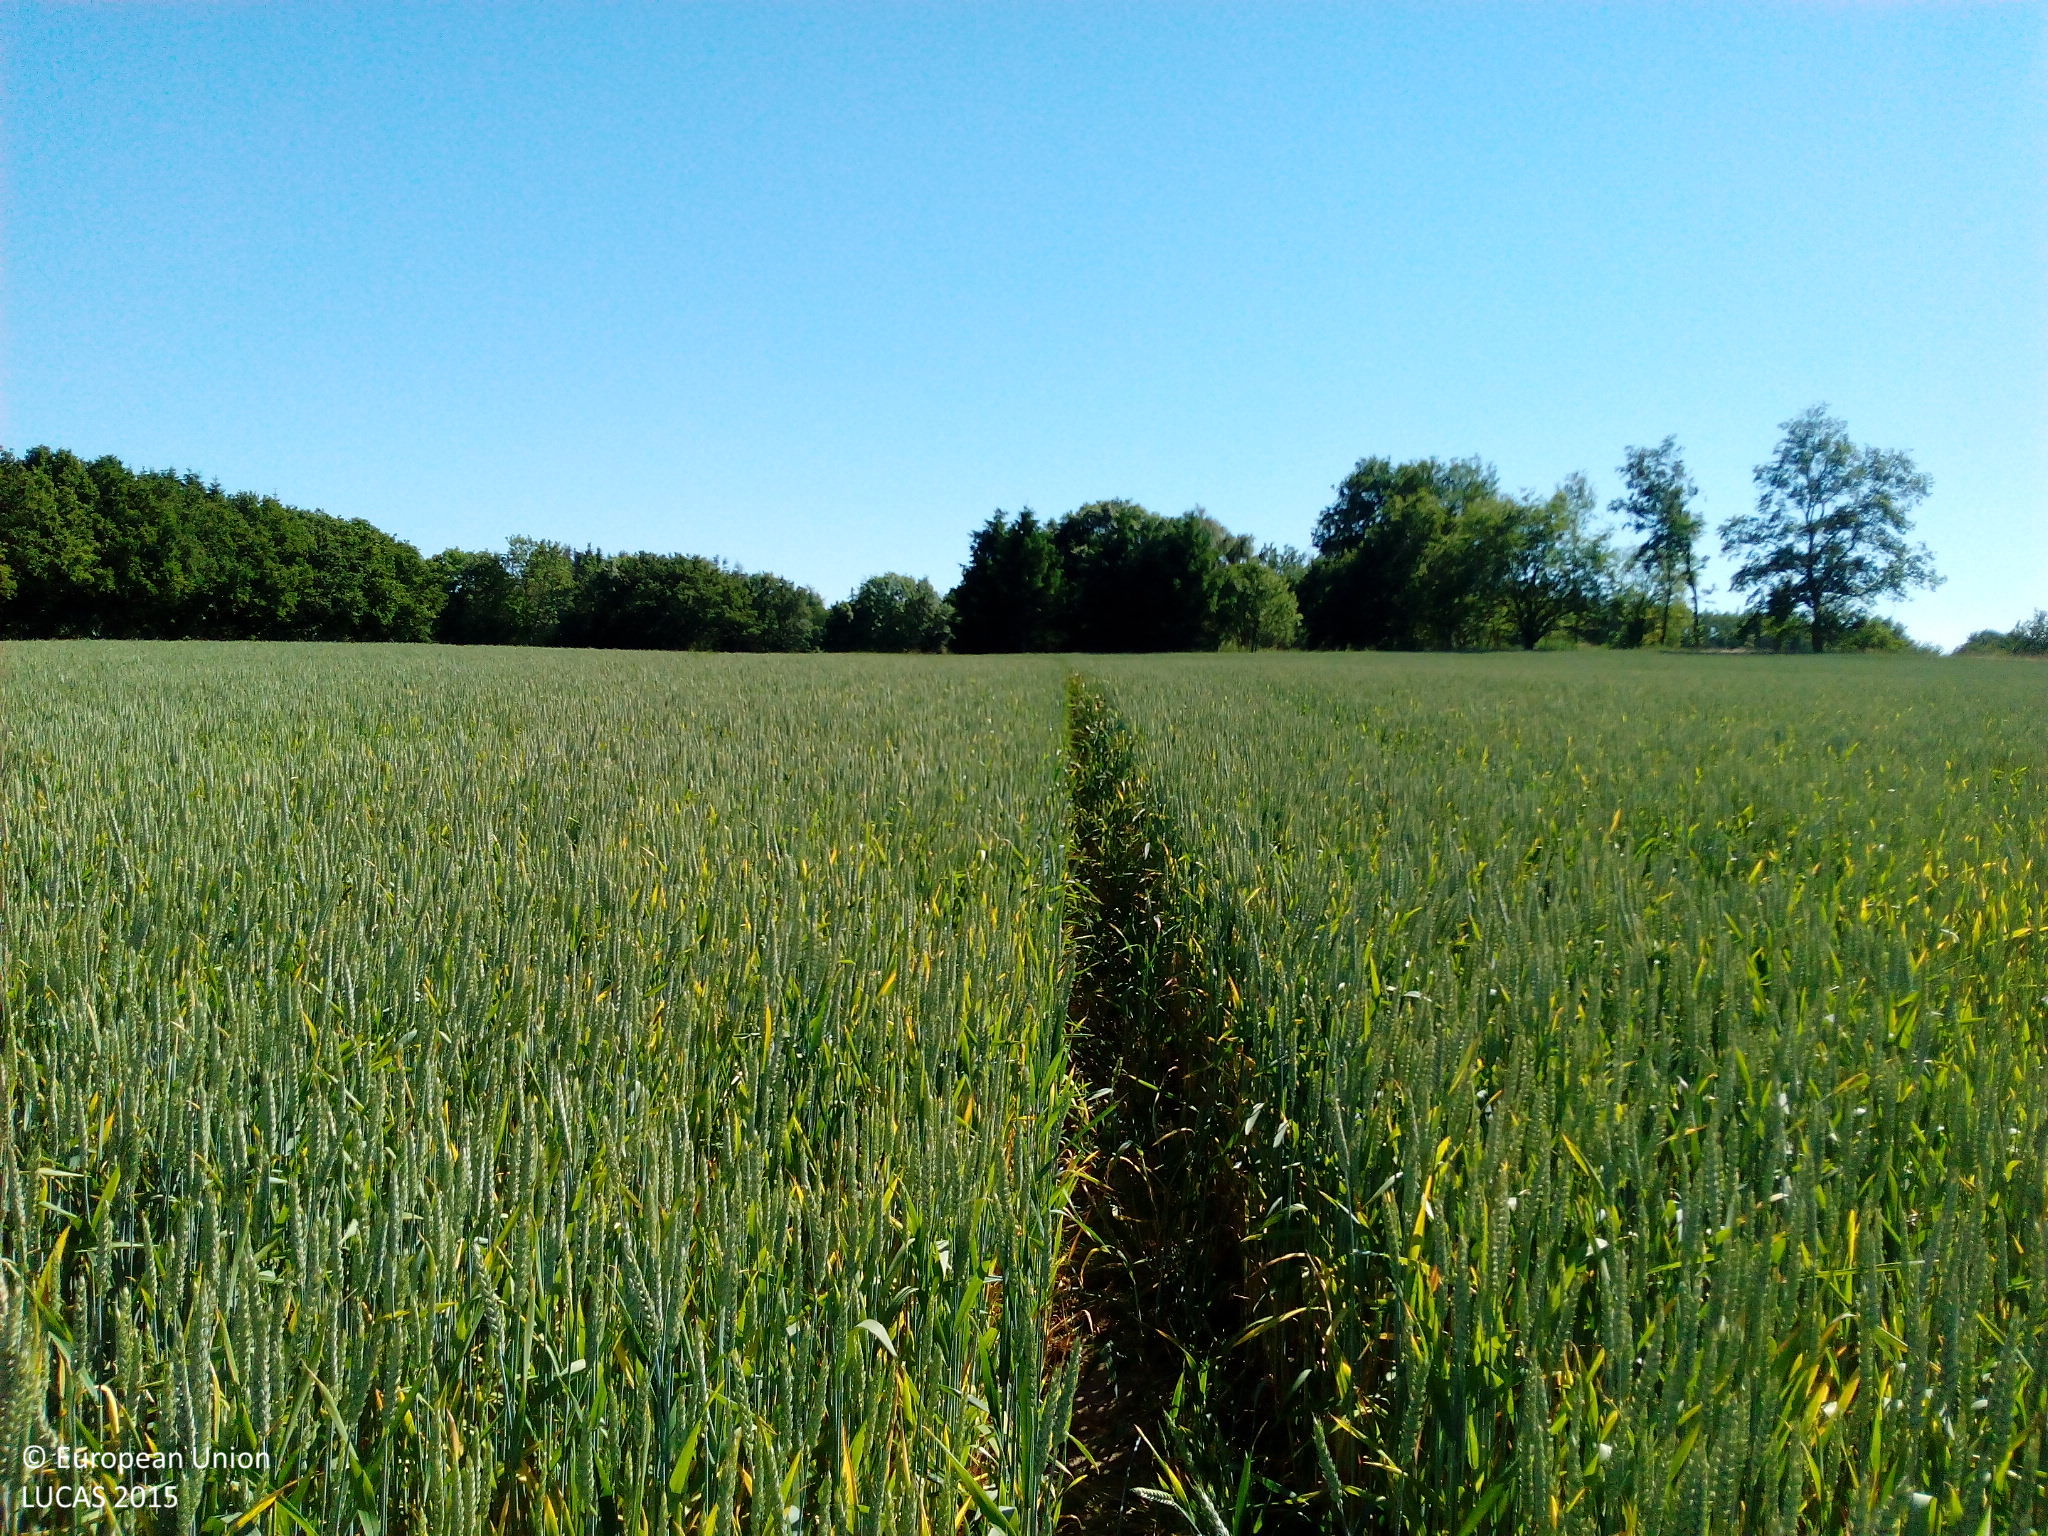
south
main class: Cropland
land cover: Common wheat
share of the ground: > 75 %
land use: Agriculture (excluding fallow land and kitchen gardens)
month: July
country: DK
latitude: 56.4373
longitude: 10.7289
